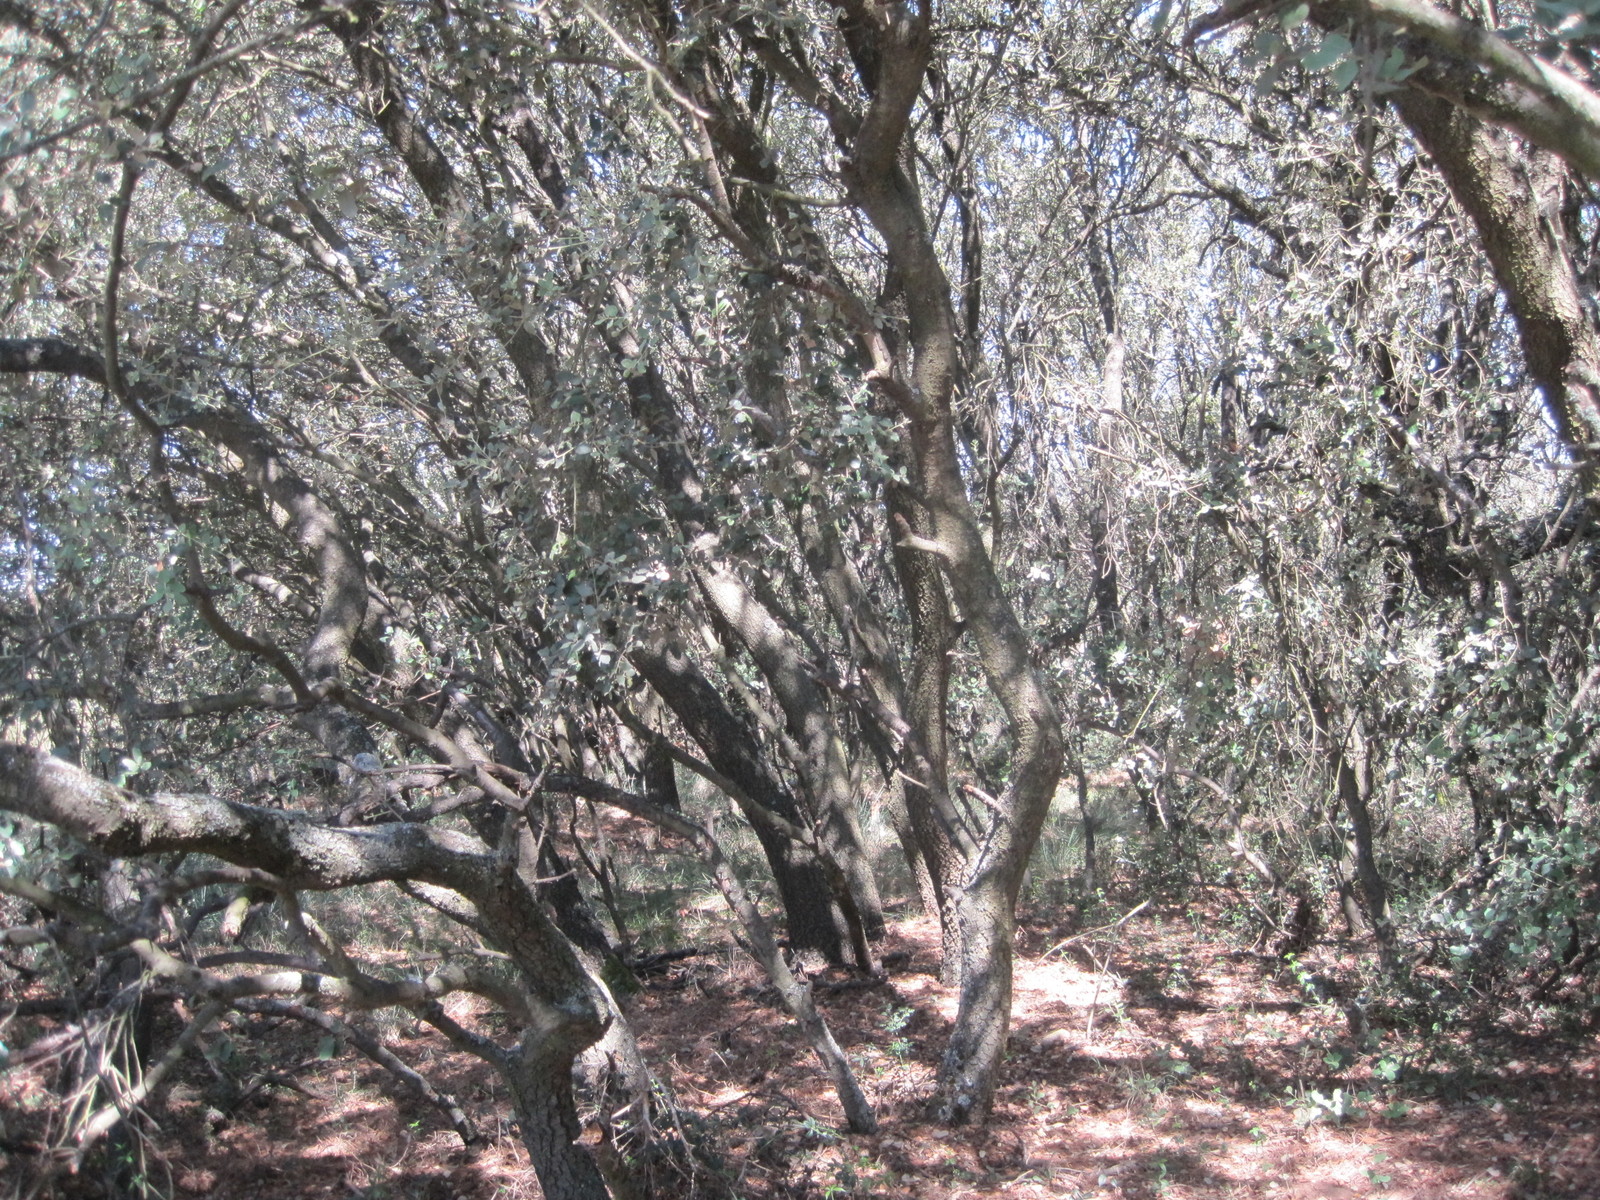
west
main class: Woodland
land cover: Broadleaved woodland
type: thermophilous deciduous forest
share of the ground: > 75 %
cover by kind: broadleaved forest trees 75 %, herbaceous plants 25 %
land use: Forestry
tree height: > 5 m
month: July
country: ES
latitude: 41.8913
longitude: -4.6664
